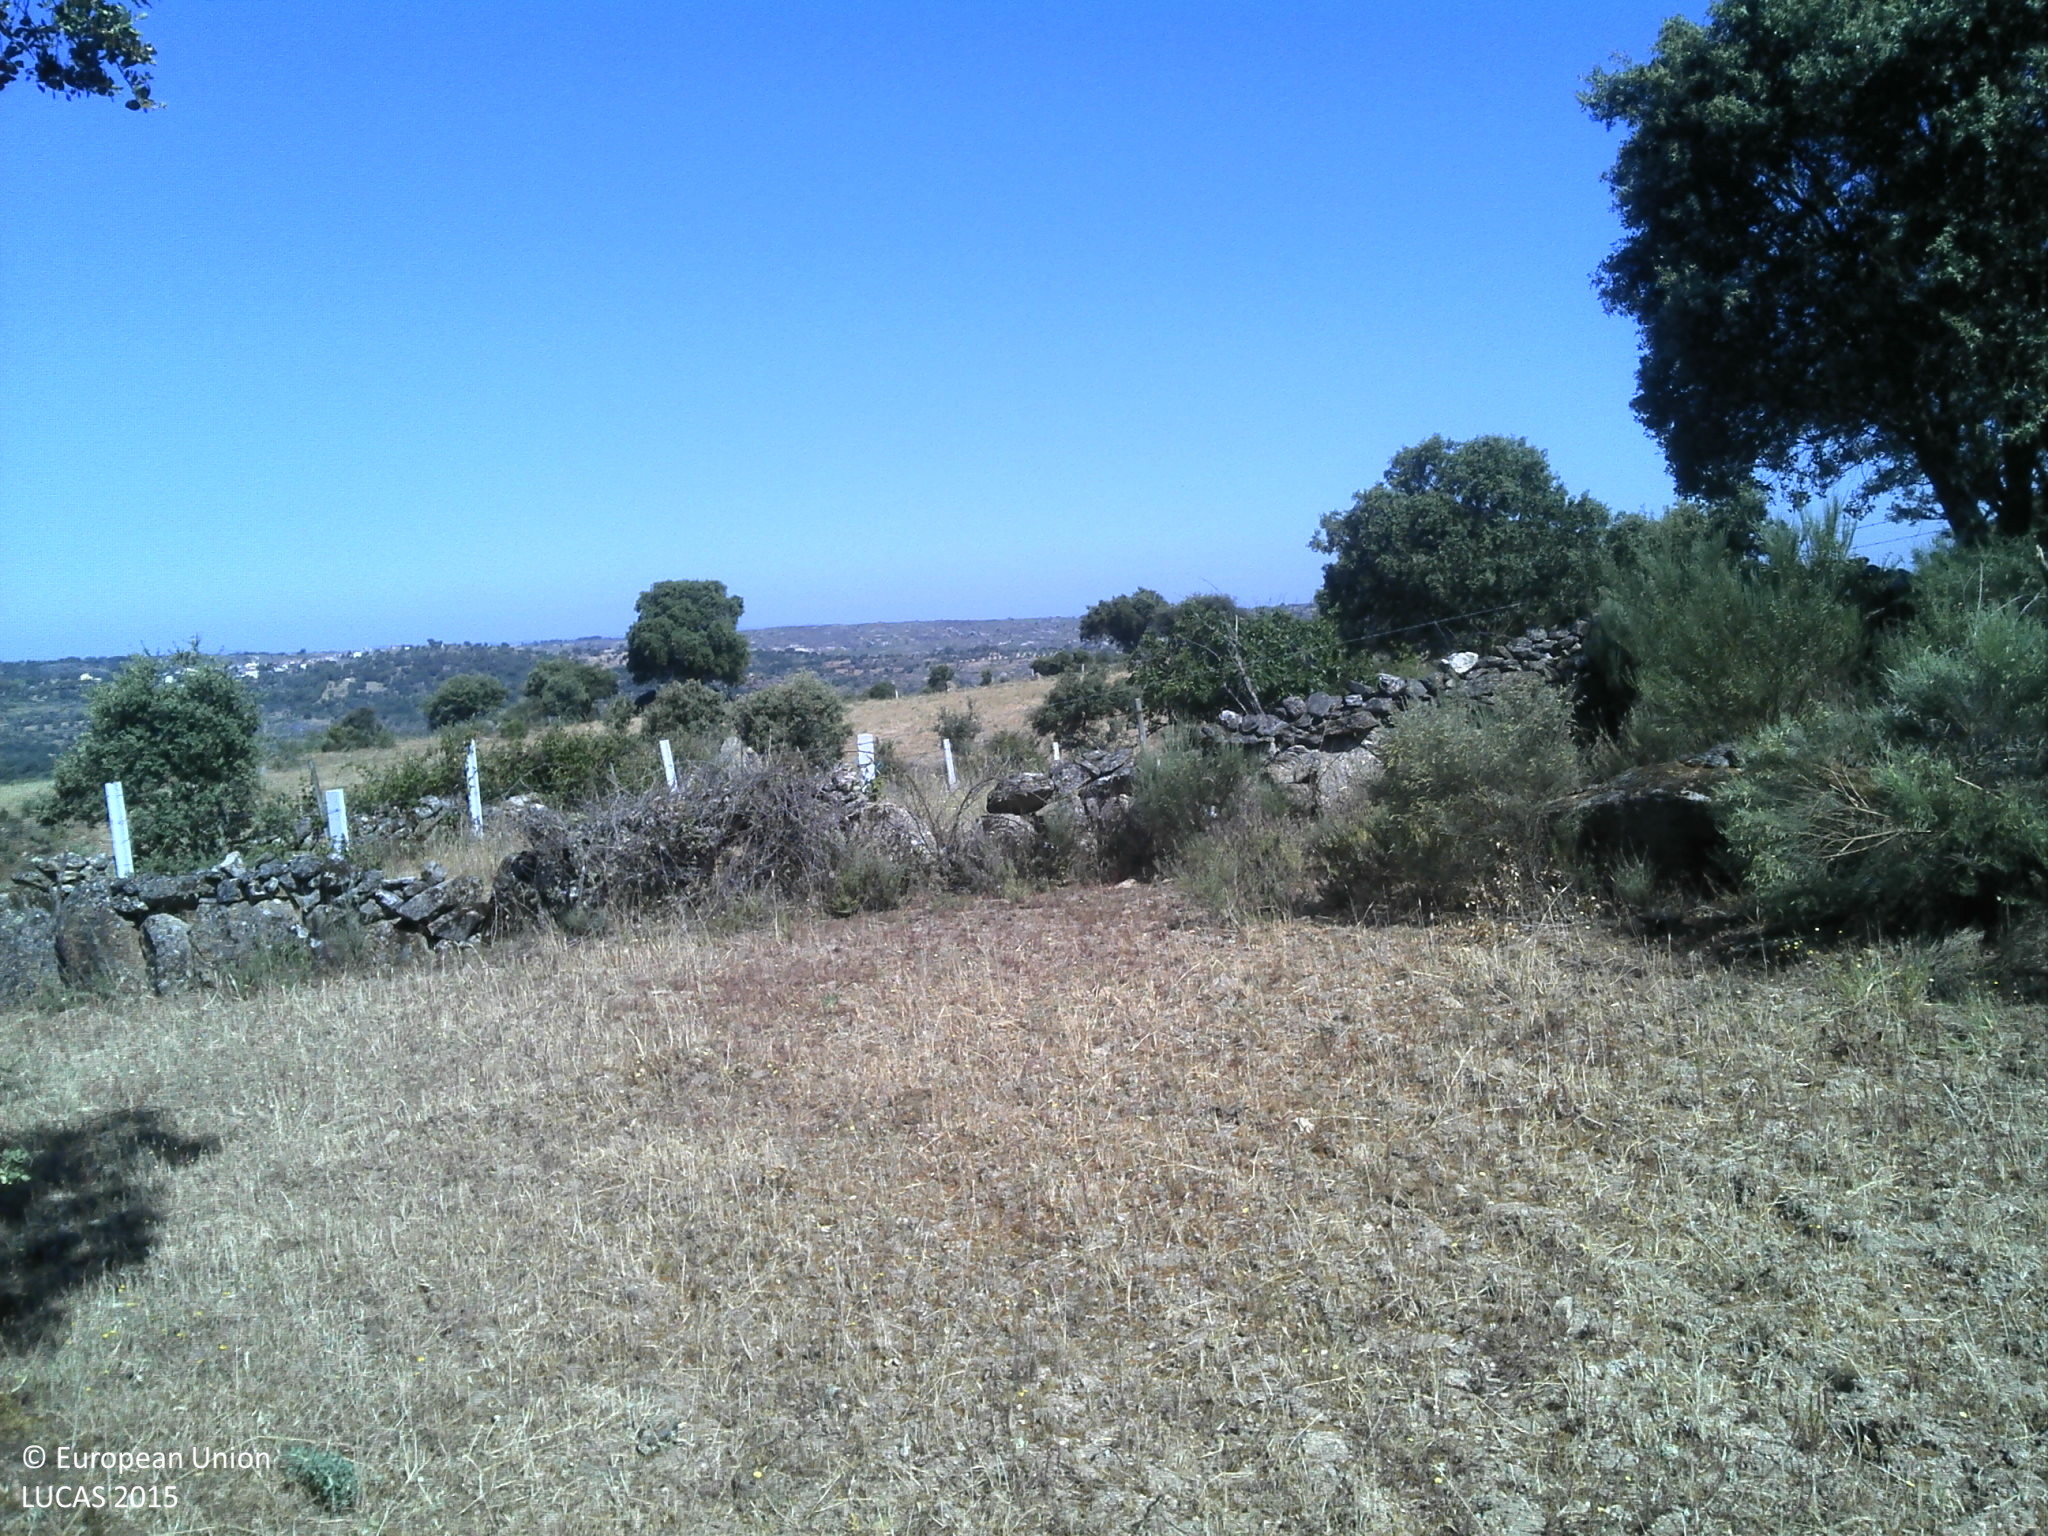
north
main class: Grassland
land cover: Grassland with sparse tree/shrub cover
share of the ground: 50 - 75 %
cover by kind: unconsolidated bare surface 50 %, herbaceous plants 40 %, broadleaved forest trees 5 %, shrubs 5 %
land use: Agriculture (excluding fallow land and kitchen gardens)
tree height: > 5 m
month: June
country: PT
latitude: 40.6516
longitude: -7.0013
